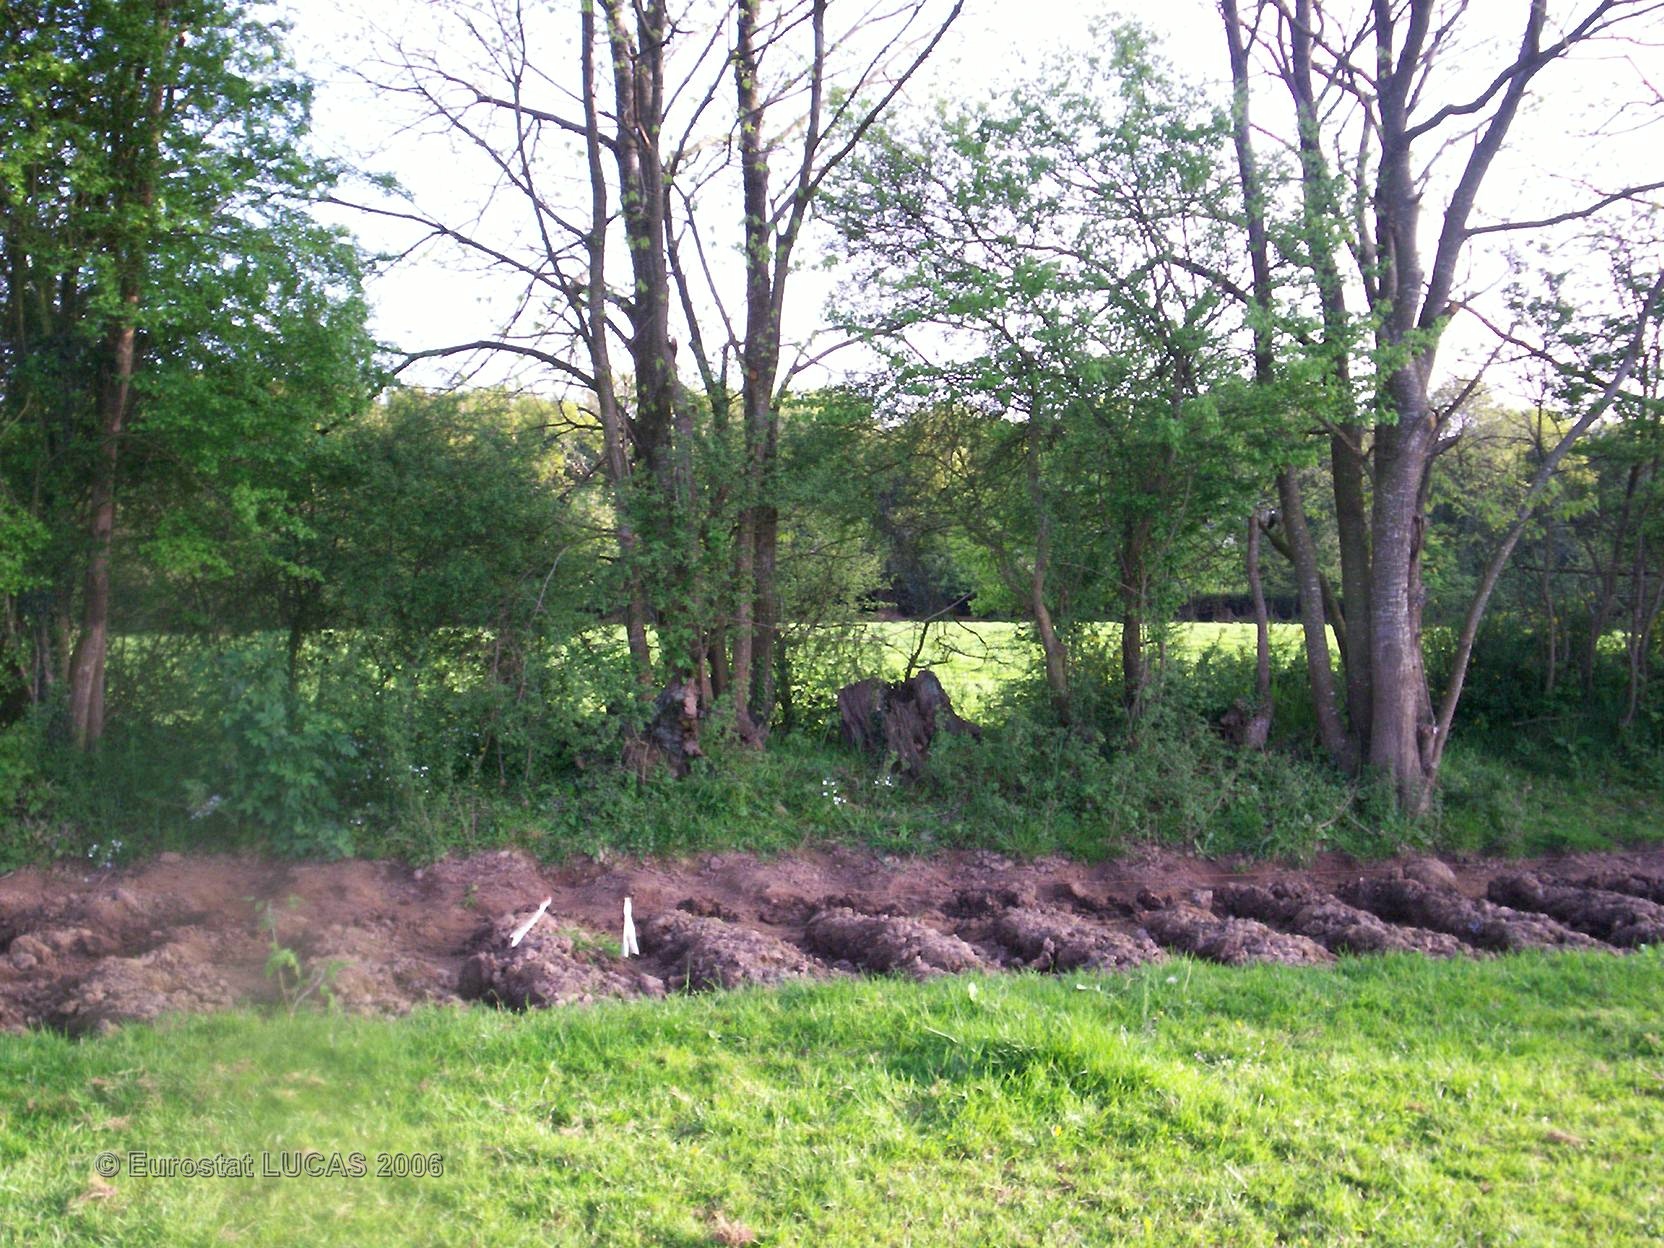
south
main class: Grassland
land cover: Grassland without tree/shrub cover
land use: Agriculture (excluding fallow land and kitchen gardens)
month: May
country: FR
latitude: 47.9945
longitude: -2.8635
